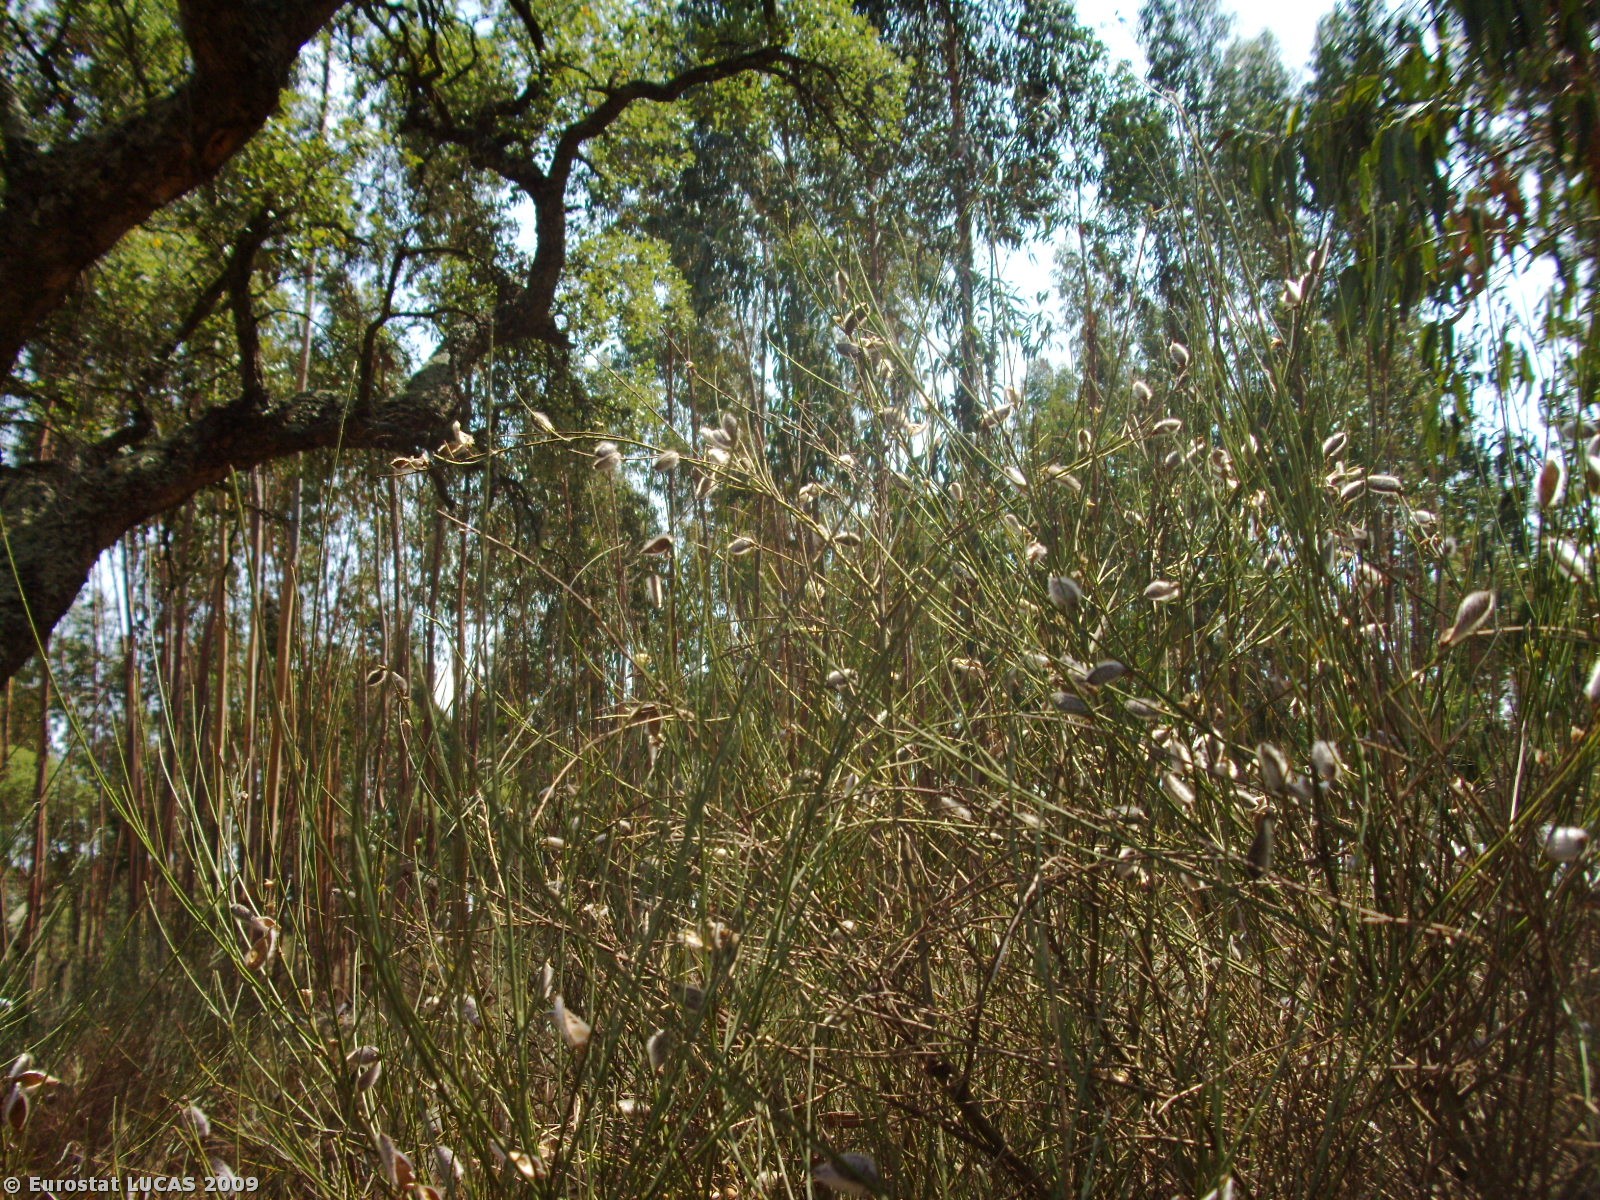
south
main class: Woodland
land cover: Broadleaved woodland
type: plantations and self-sown exotic forest
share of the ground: 50 - 75 %
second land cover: Spontaneously vegetated surfaces
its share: 10 - 25 %
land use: Forestry
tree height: > 5 m
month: August
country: PT
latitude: 39.2828
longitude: -8.1321
